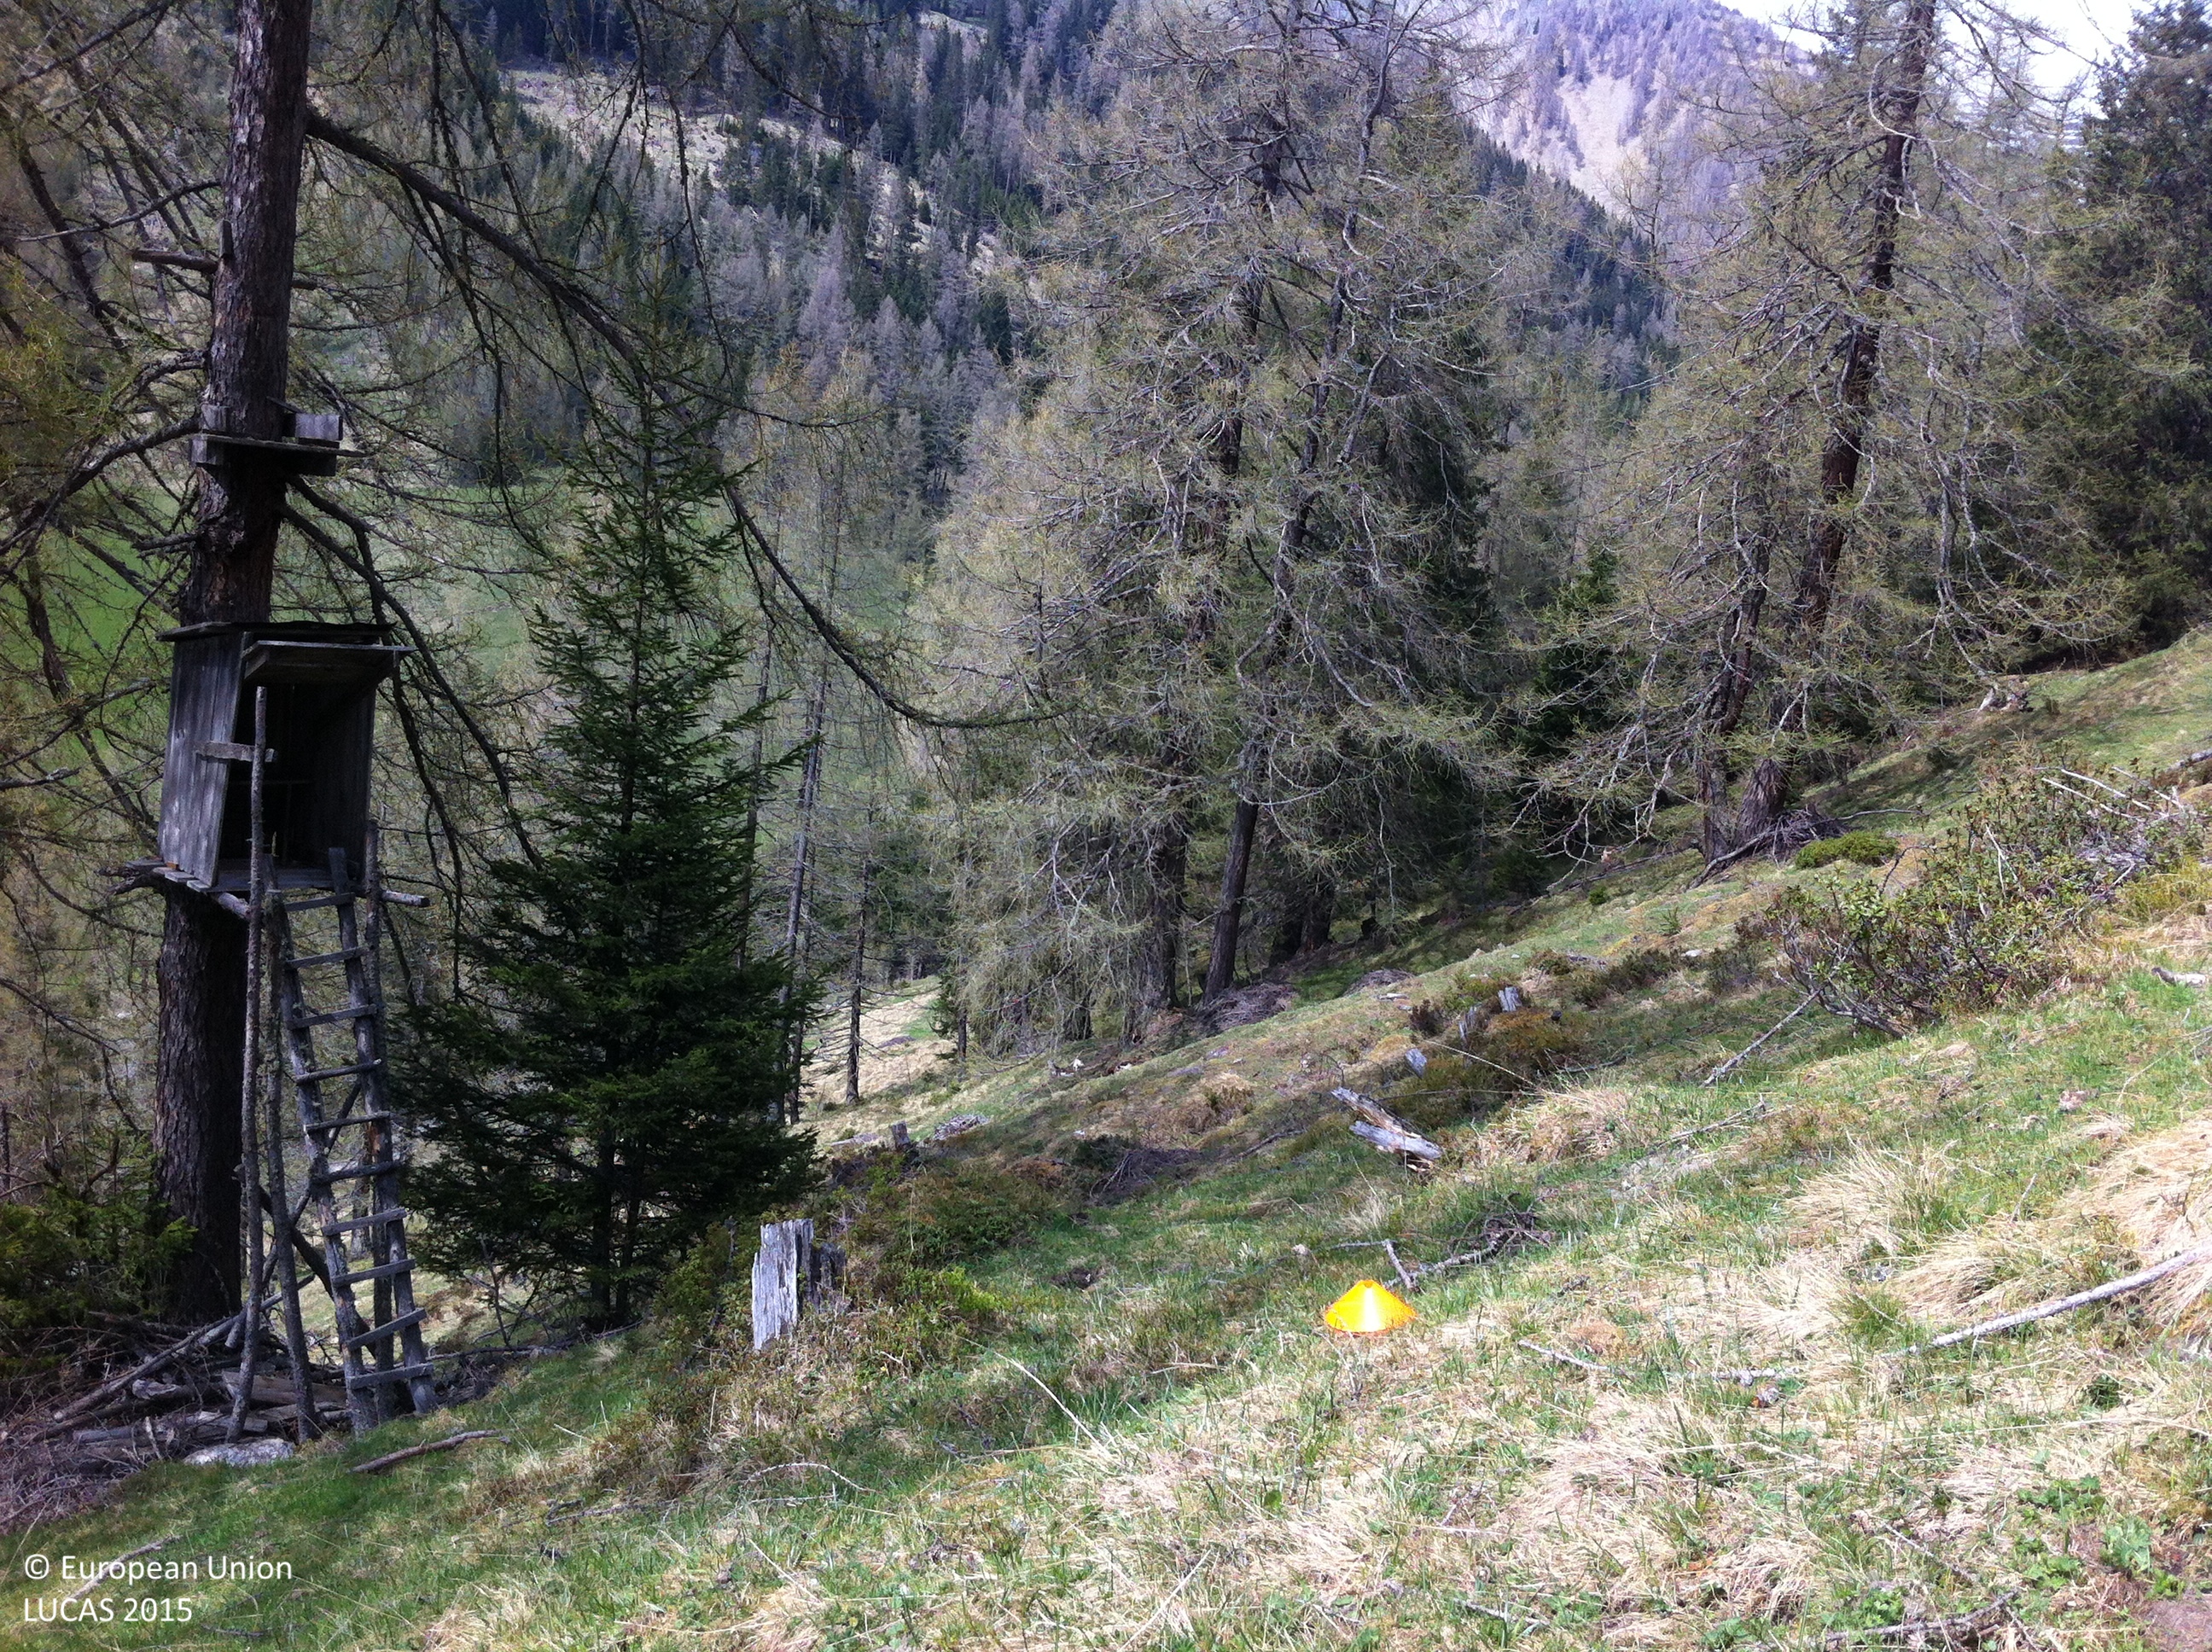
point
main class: Shrubland
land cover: Shrubland with sparse tree cover
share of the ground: 50 - 75 %
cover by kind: shrubs 50 %, herbaceous plants 35 %, lichens and mosses 10 %, coniferous forest trees 5 %
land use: Forestry
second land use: Agriculture (excluding fallow land and kitchen gardens)
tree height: < 5 m
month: May
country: AT
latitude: 47.0958
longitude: 11.5926
